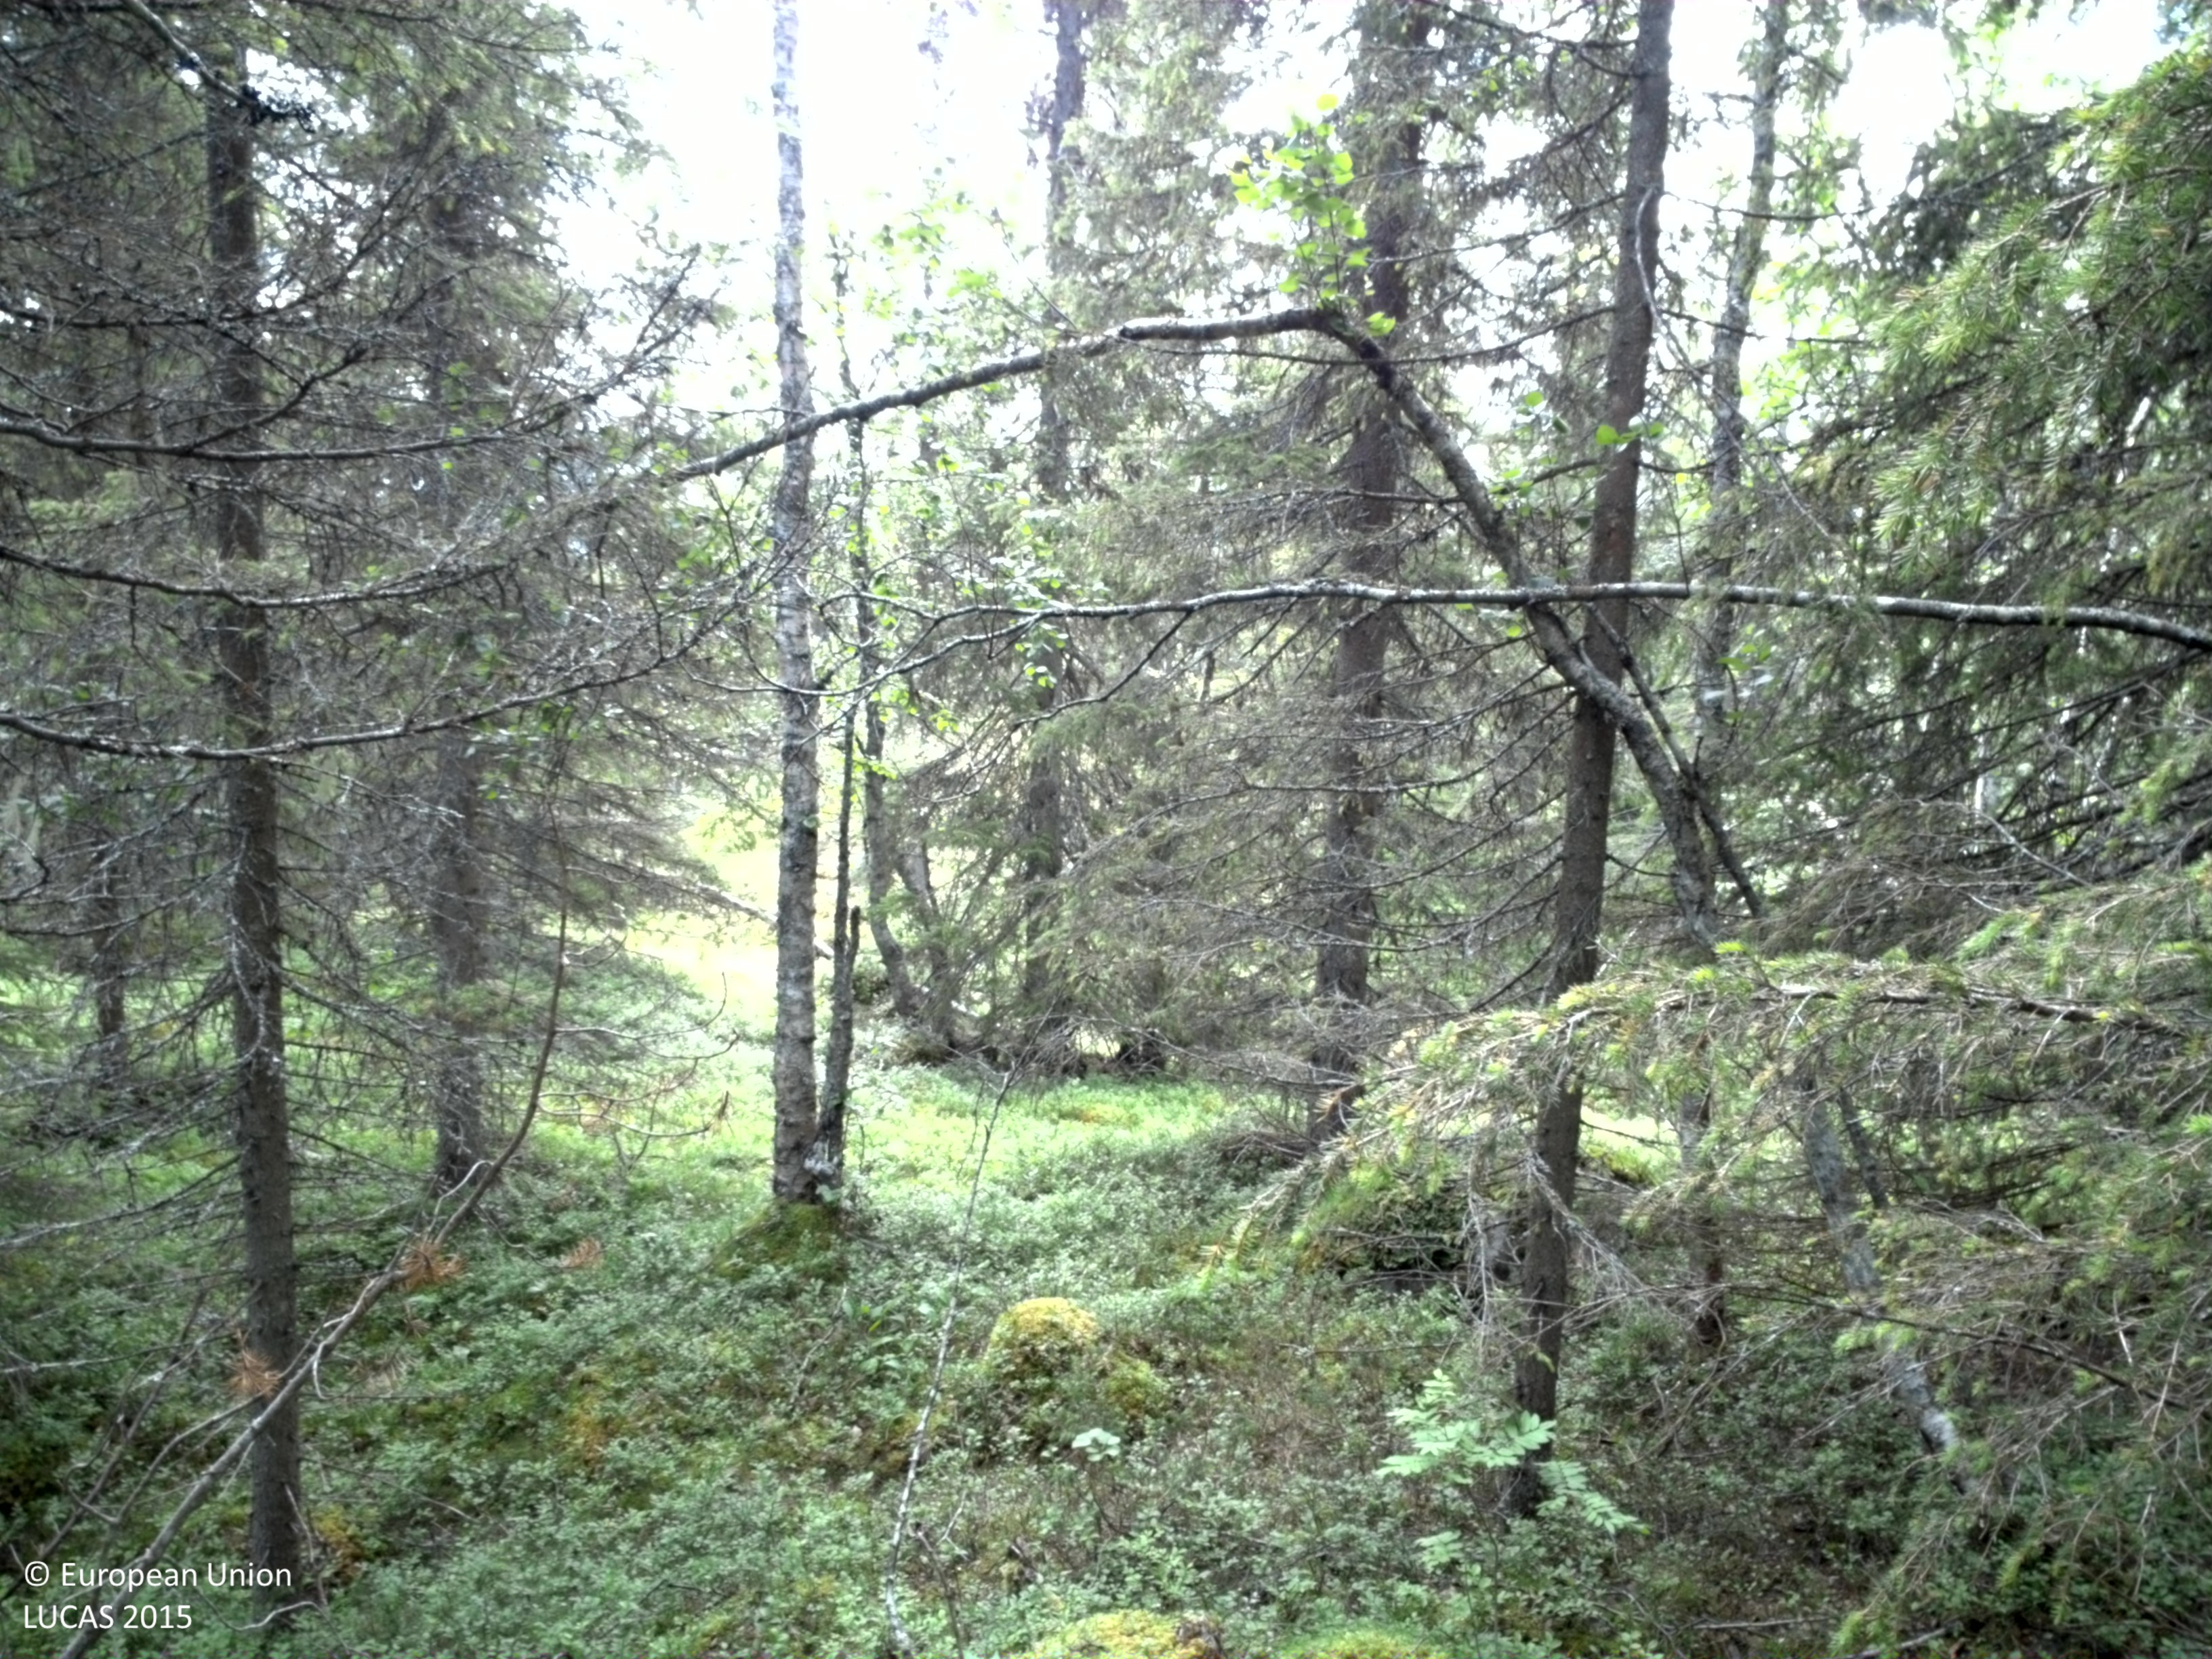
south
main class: Woodland
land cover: Spruce dominated coniferous woodland
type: hemiboreal forest and nemoral coniferous forest and mixed broadleaved-coniferous forest
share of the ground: 25 - 50 %
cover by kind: shrubs 65 %, coniferous forest trees 35 %
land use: Forestry
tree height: > 5 m
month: August
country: SE
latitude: 66.5345
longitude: 20.7822
